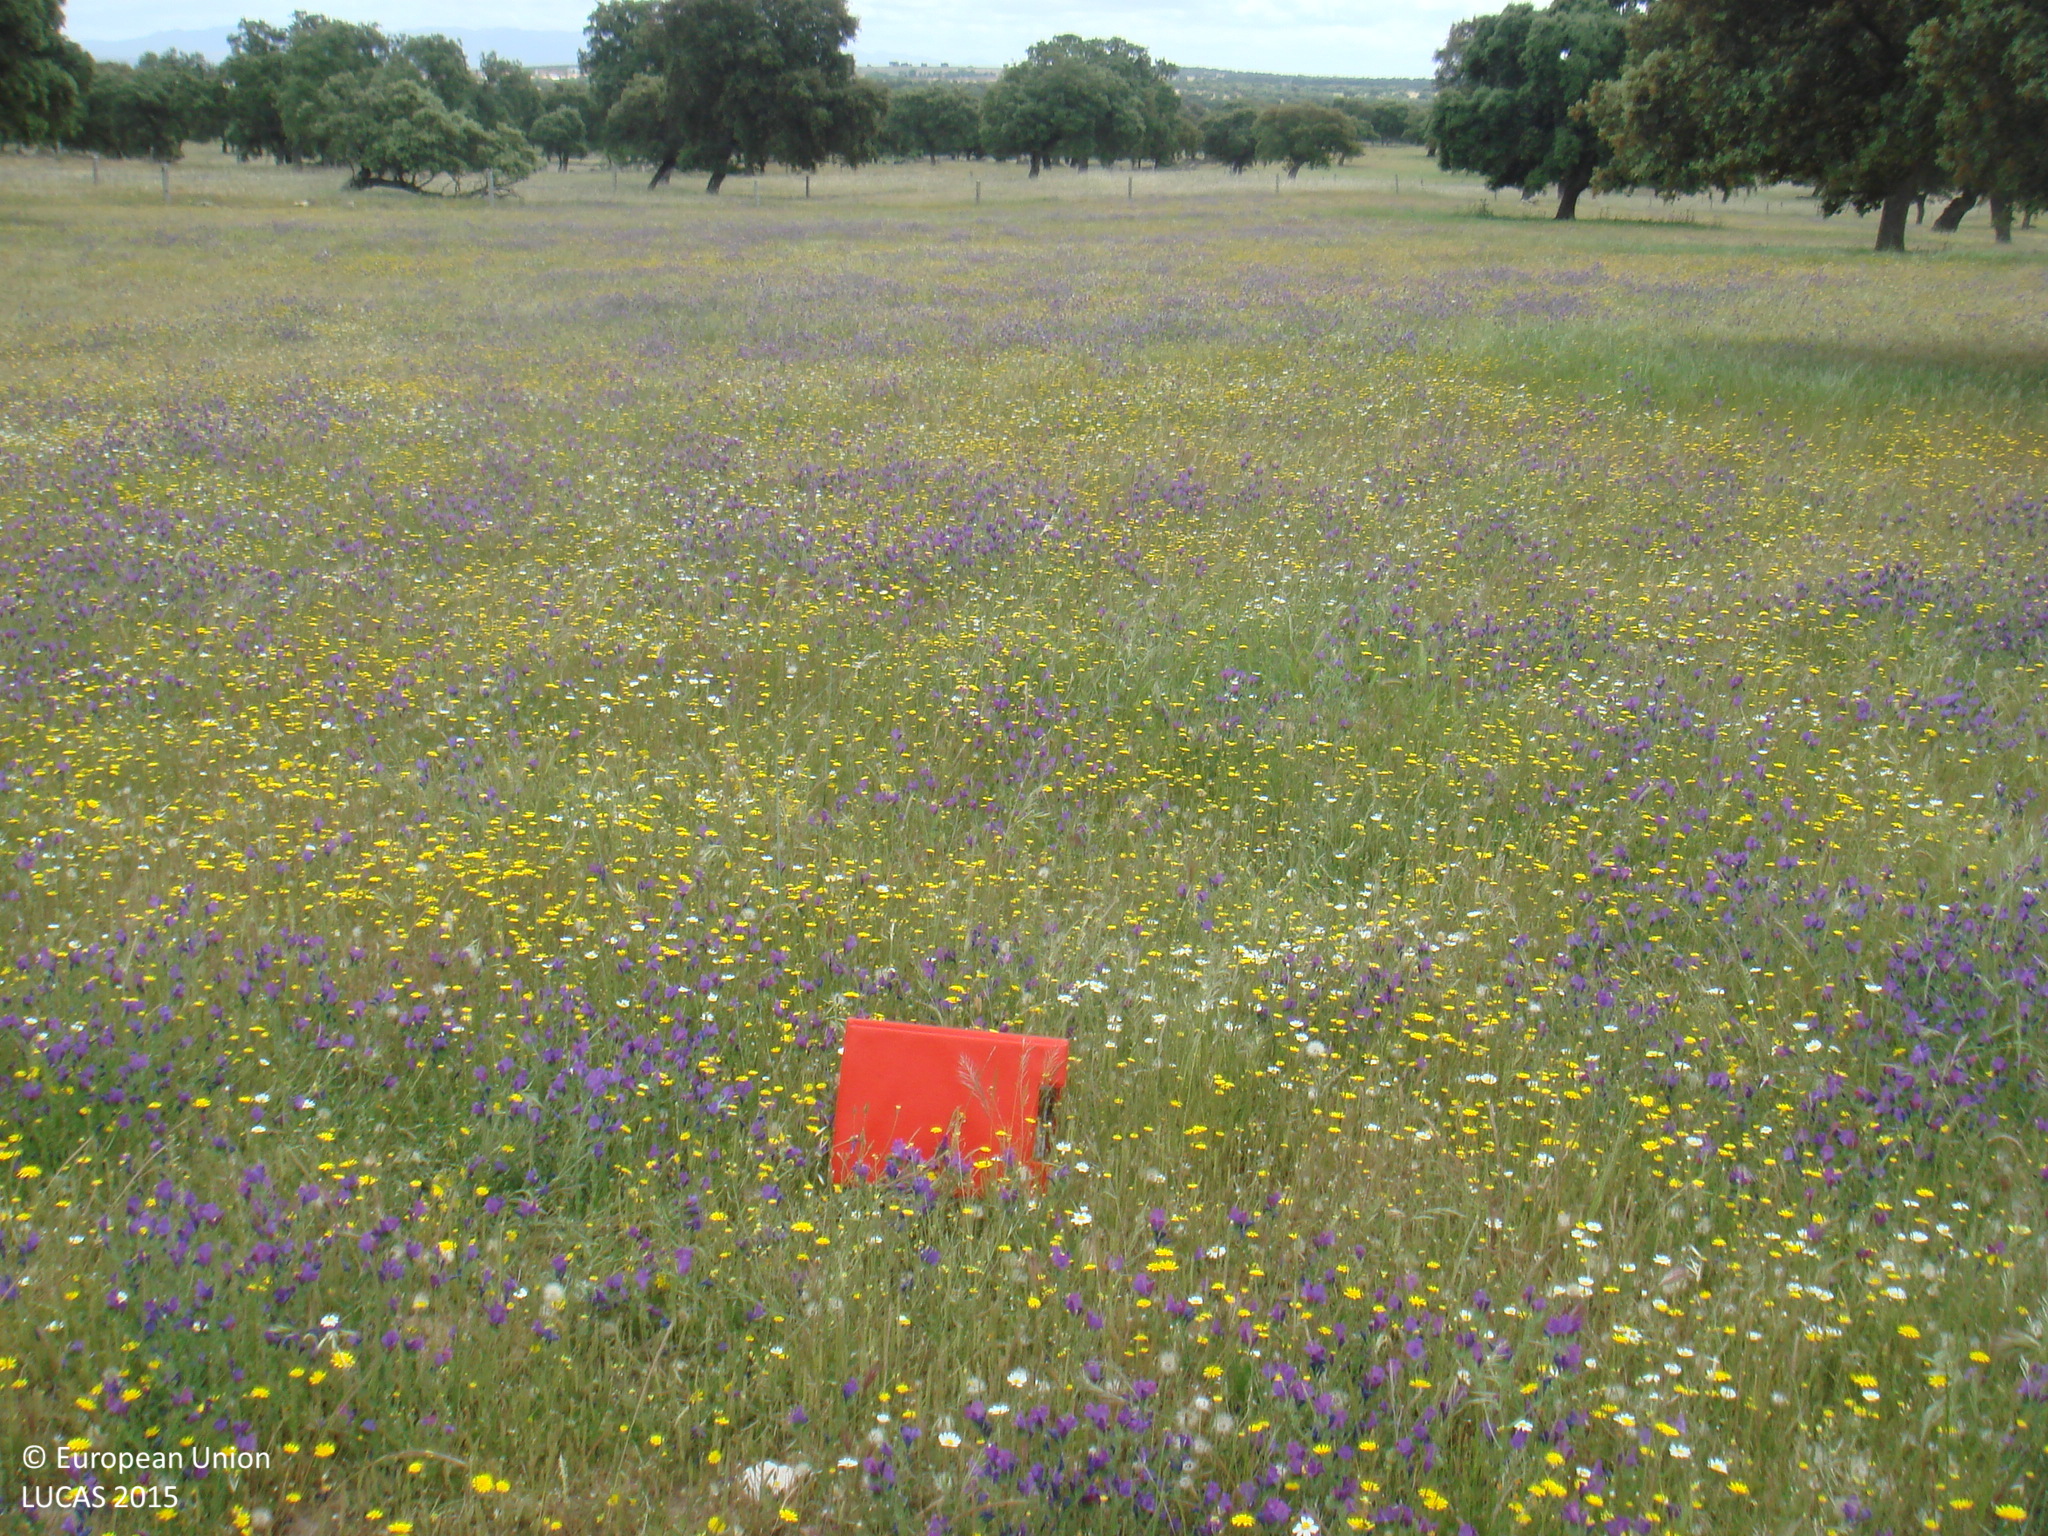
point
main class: Woodland
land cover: Broadleaved woodland
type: broadleaved evergreen forest
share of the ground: 10 - 25 %
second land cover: Spontaneously vegetated surfaces
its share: > 75 %
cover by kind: herbaceous plants 70 %, shrubs 20 %, broadleaved forest trees 10 %
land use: Forestry
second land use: Agriculture (excluding fallow land and kitchen gardens)
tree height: > 5 m
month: May
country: ES
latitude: 38.4729
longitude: -4.7059
